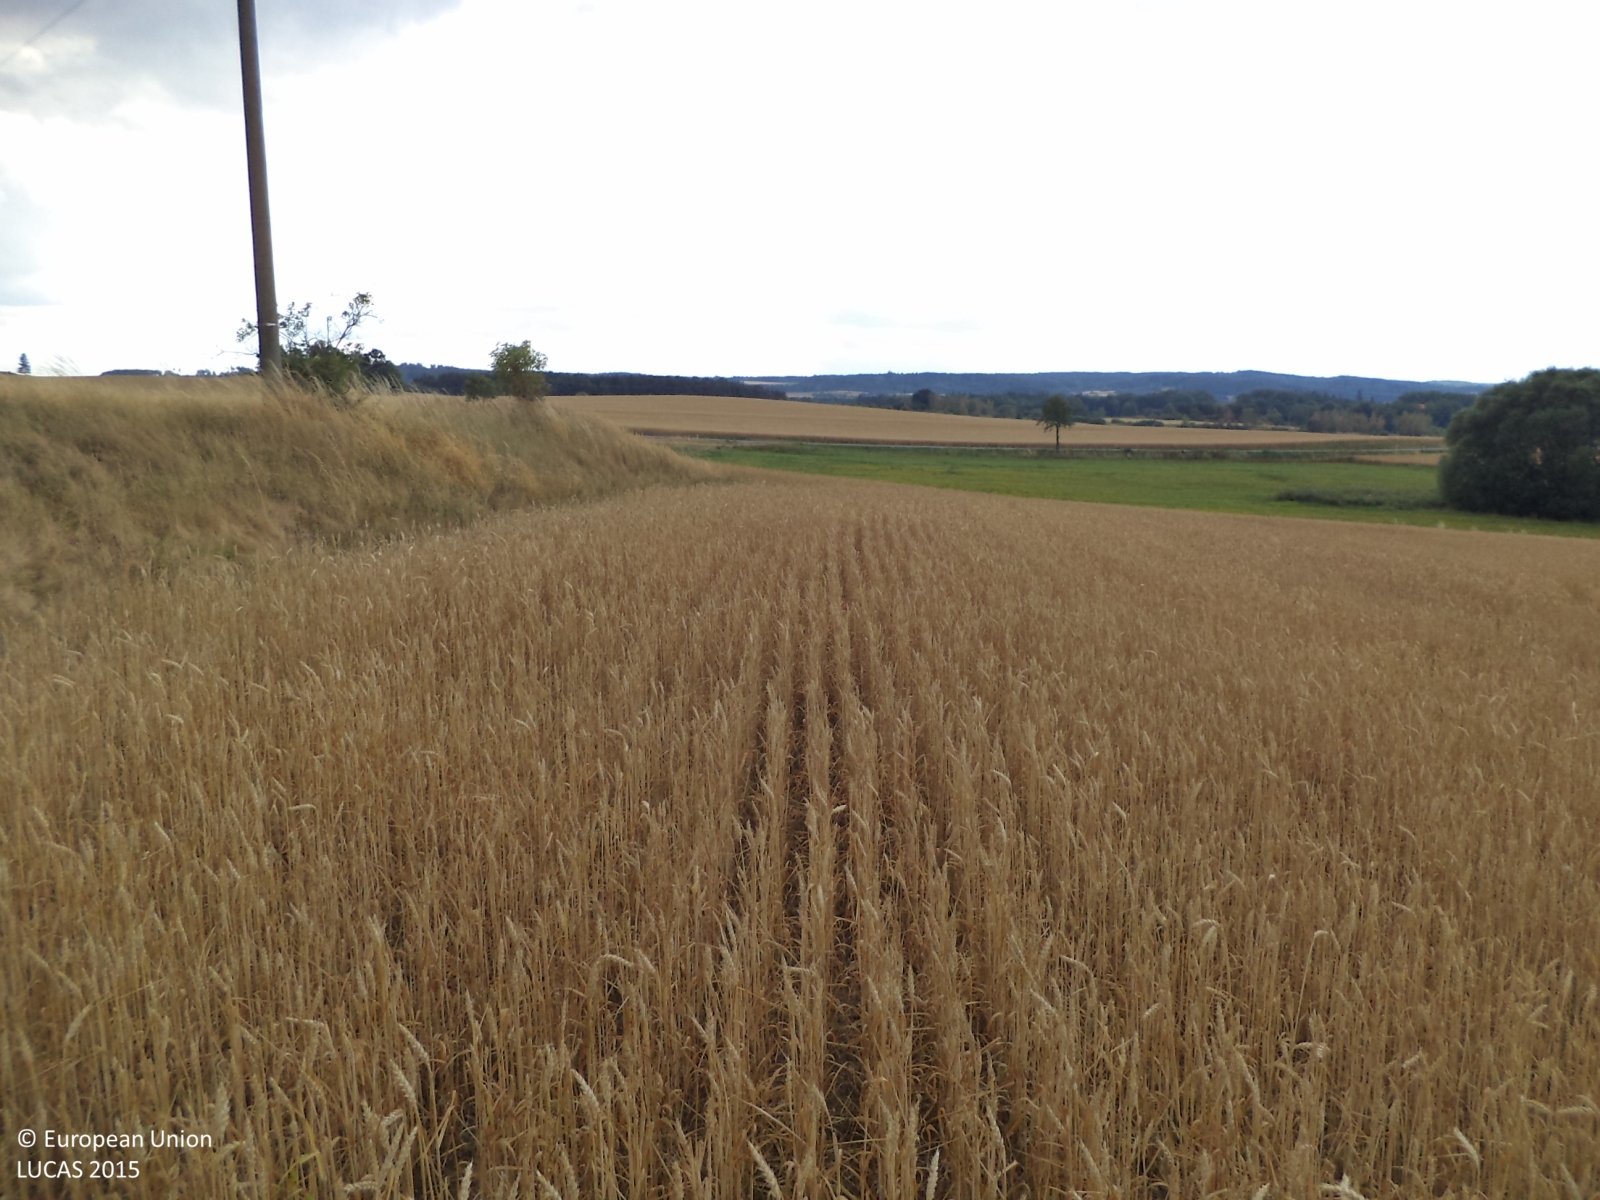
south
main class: Cropland
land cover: Common wheat
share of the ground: > 75 %
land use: Agriculture (excluding fallow land and kitchen gardens)
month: July
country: CZ
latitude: 49.4333
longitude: 13.9029
